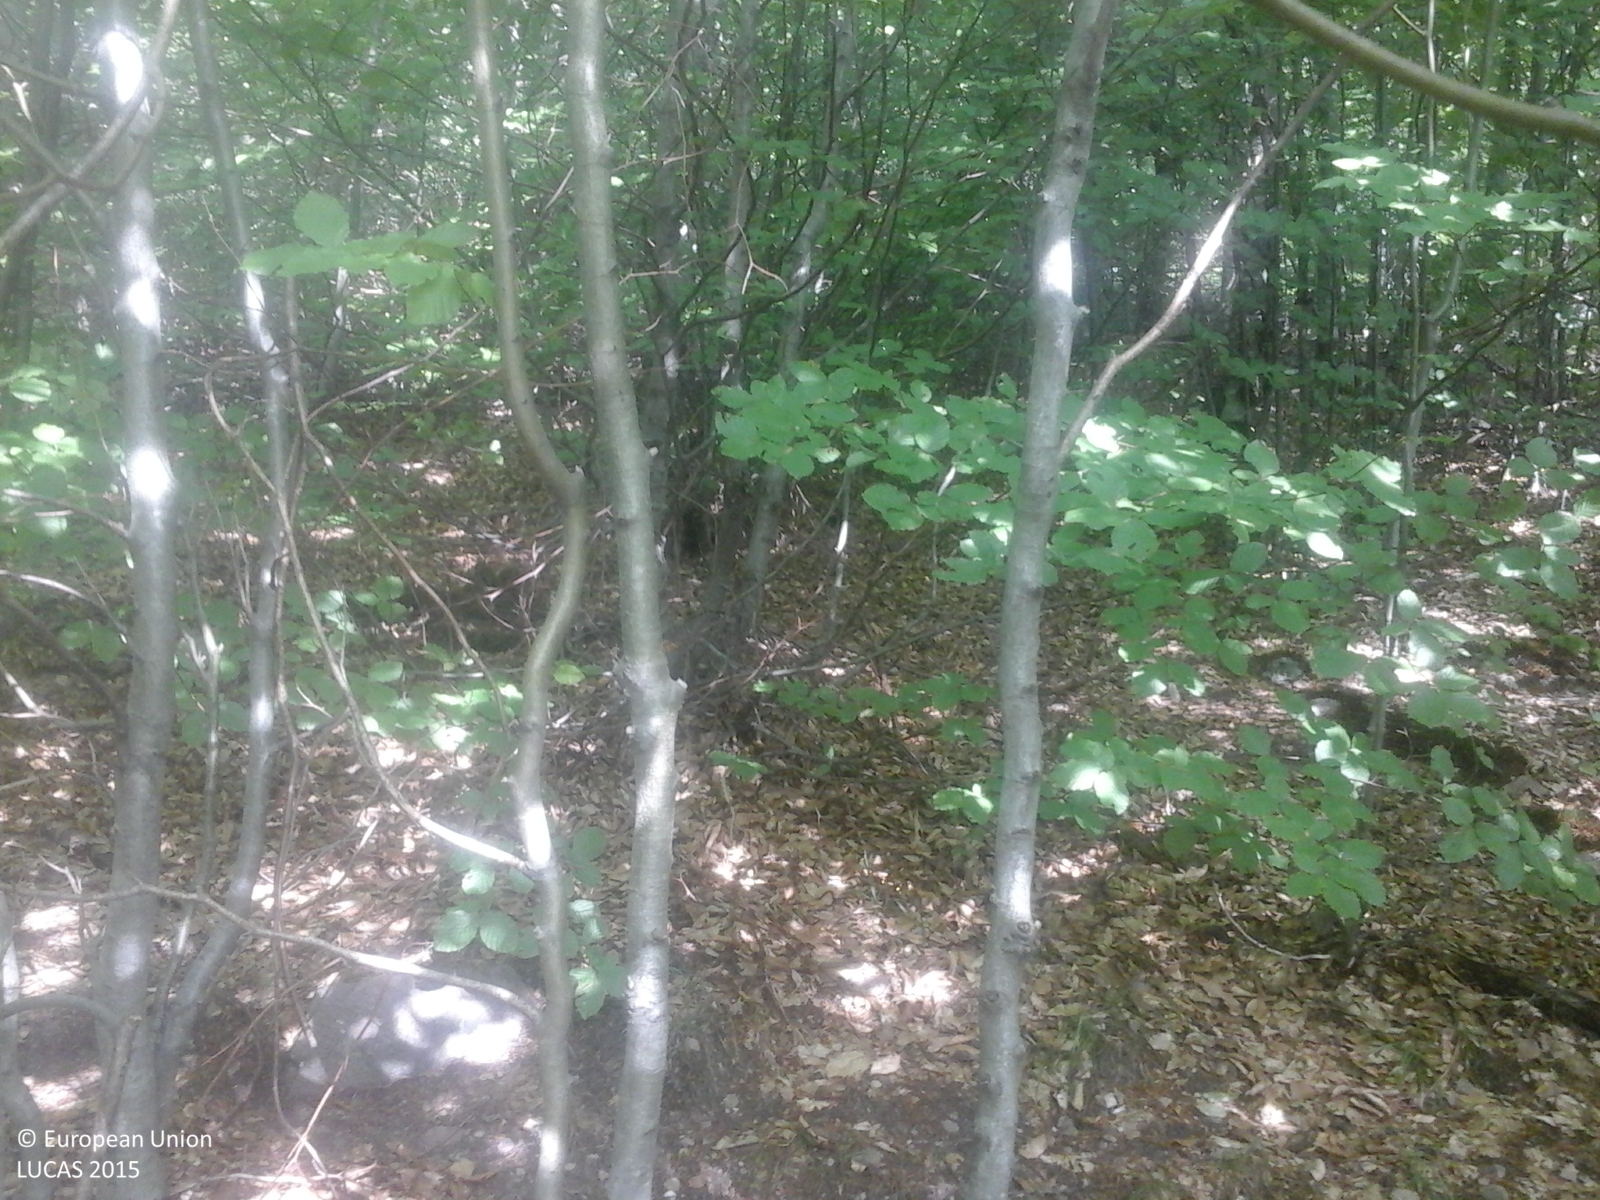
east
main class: Woodland
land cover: Broadleaved woodland
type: beech forest
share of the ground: > 75 %
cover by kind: broadleaved forest trees 100 %
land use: Forestry
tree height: > 5 m
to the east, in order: Broadleaved woodland
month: September
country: RO
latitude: 46.9674
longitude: 22.7677
